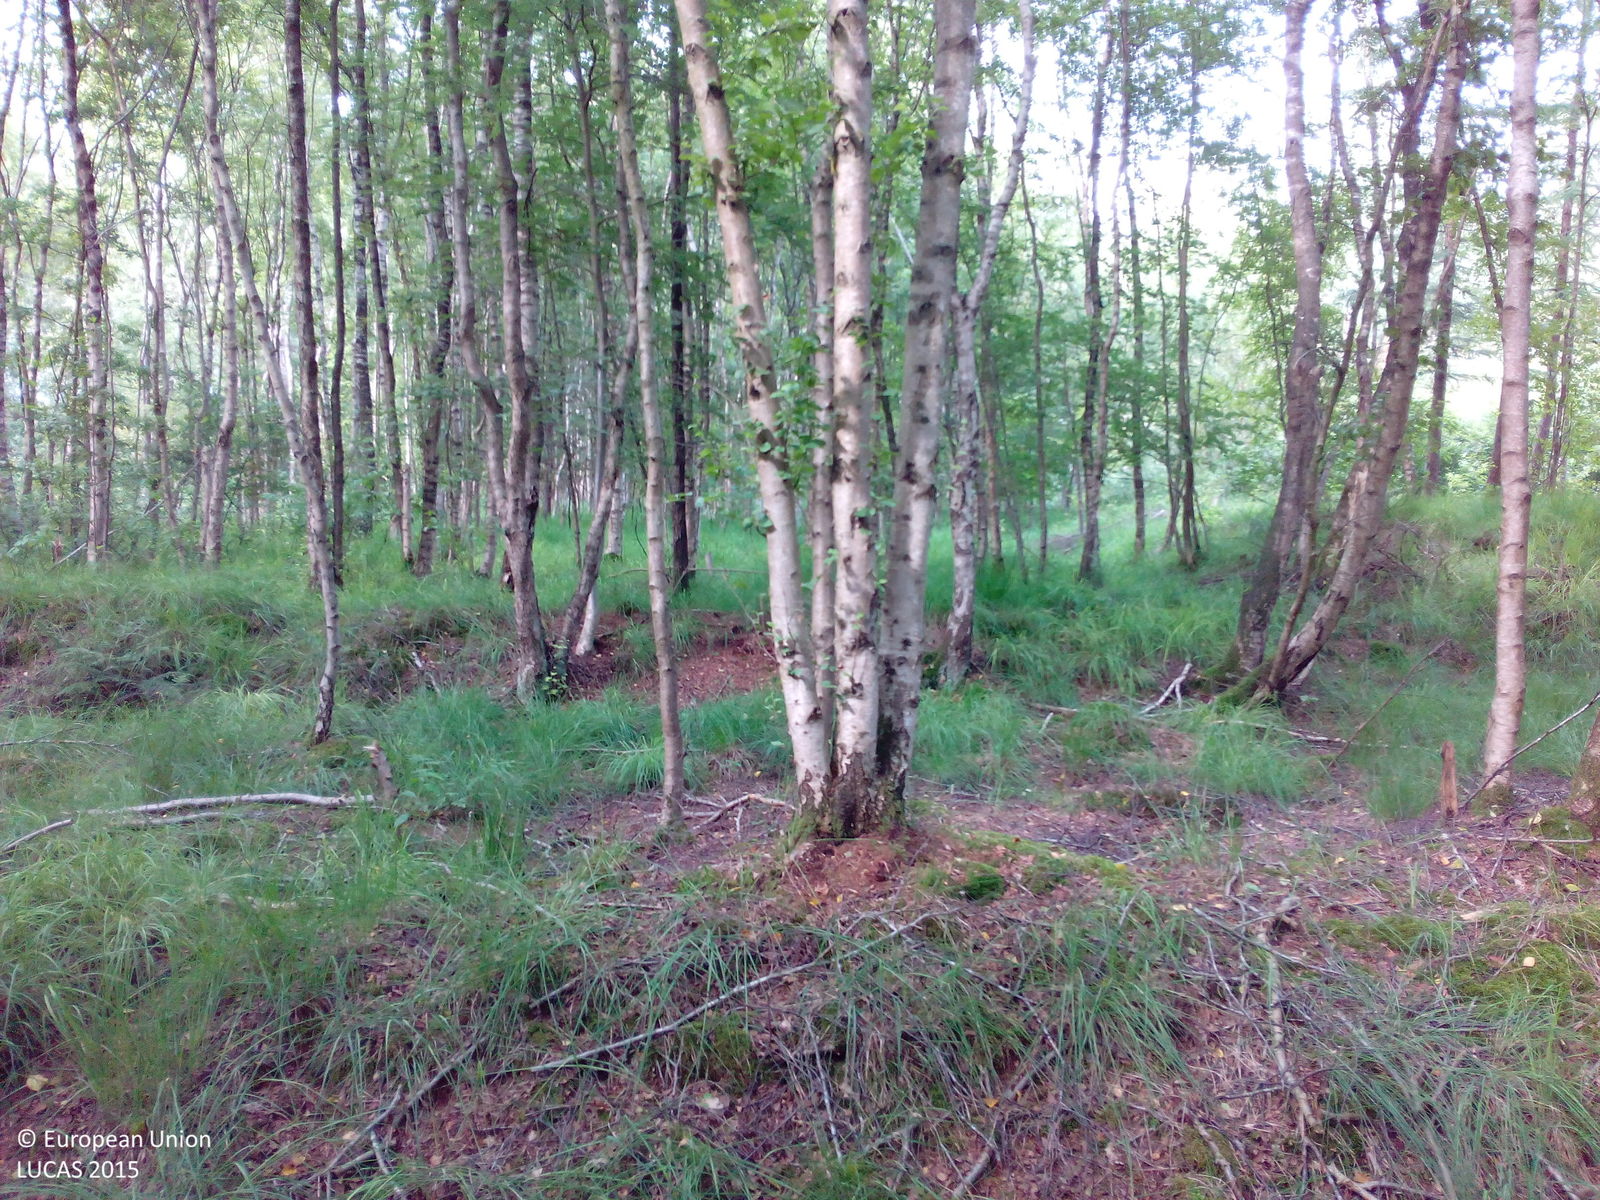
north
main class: Woodland
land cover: Broadleaved woodland
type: mire and swamp forests
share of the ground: > 75 %
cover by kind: broadleaved forest trees 85 %, coniferous forest trees 15 %
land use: Semi-natural and natural areas not in use
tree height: > 5 m
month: July
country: DE
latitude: 53.0426
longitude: 7.9274
